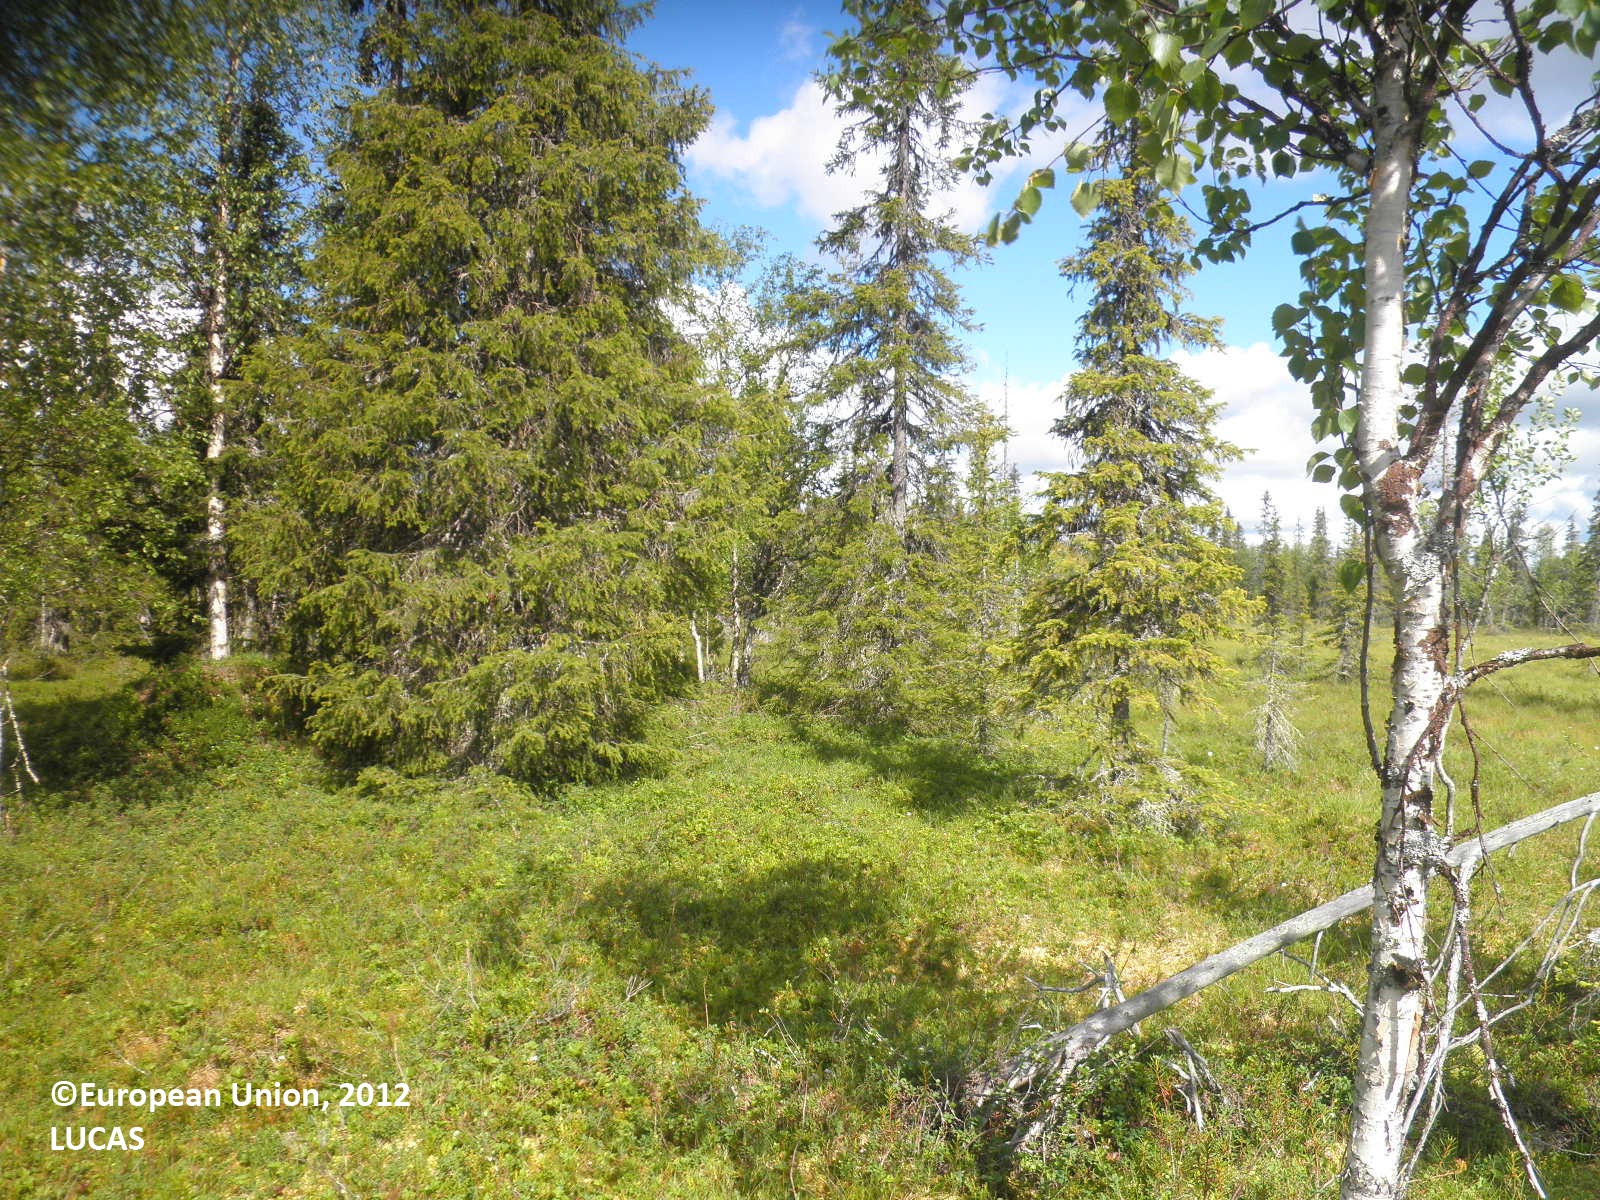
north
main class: Woodland
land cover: Spruce dominated mixed woodland
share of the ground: 10 - 25 %
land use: Forestry
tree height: > 5 m
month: July
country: FI
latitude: 67.8351
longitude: 26.3319
